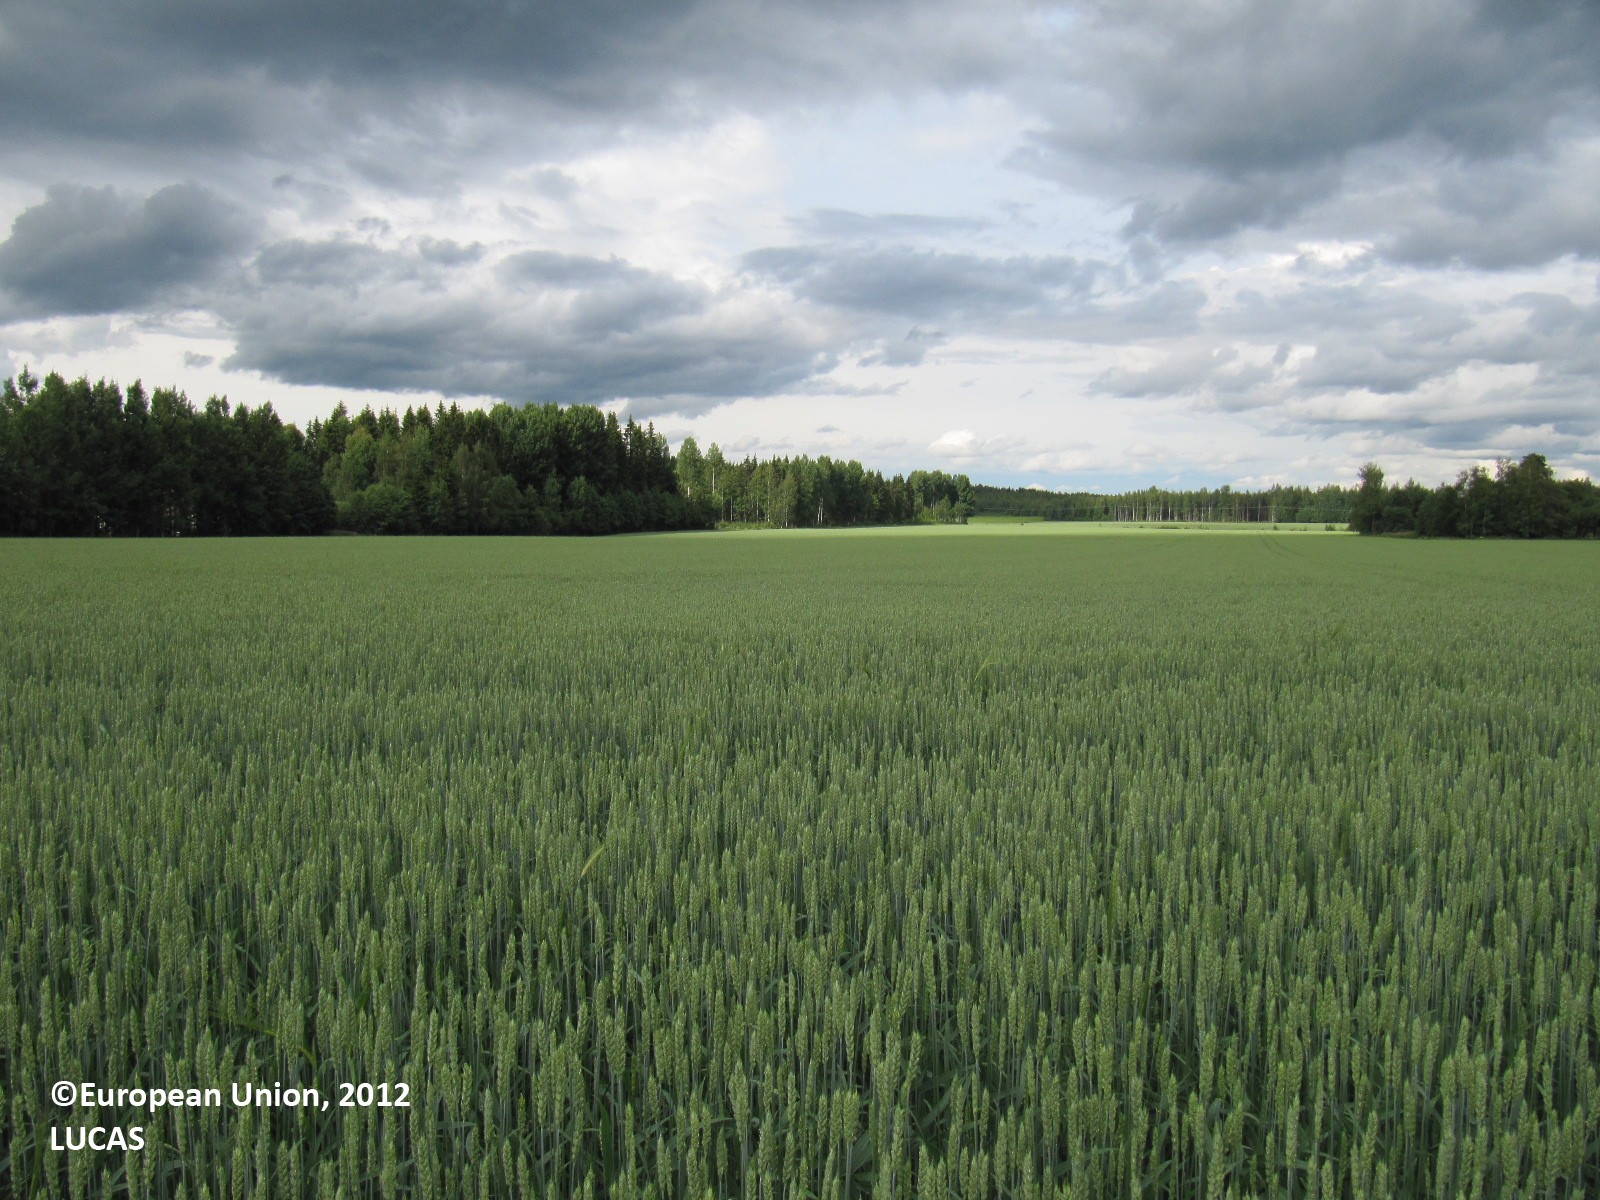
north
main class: Cropland
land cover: Common wheat
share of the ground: > 75 %
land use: Agriculture (excluding fallow land and kitchen gardens)
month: July
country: FI
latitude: 60.9112
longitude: 24.6930
